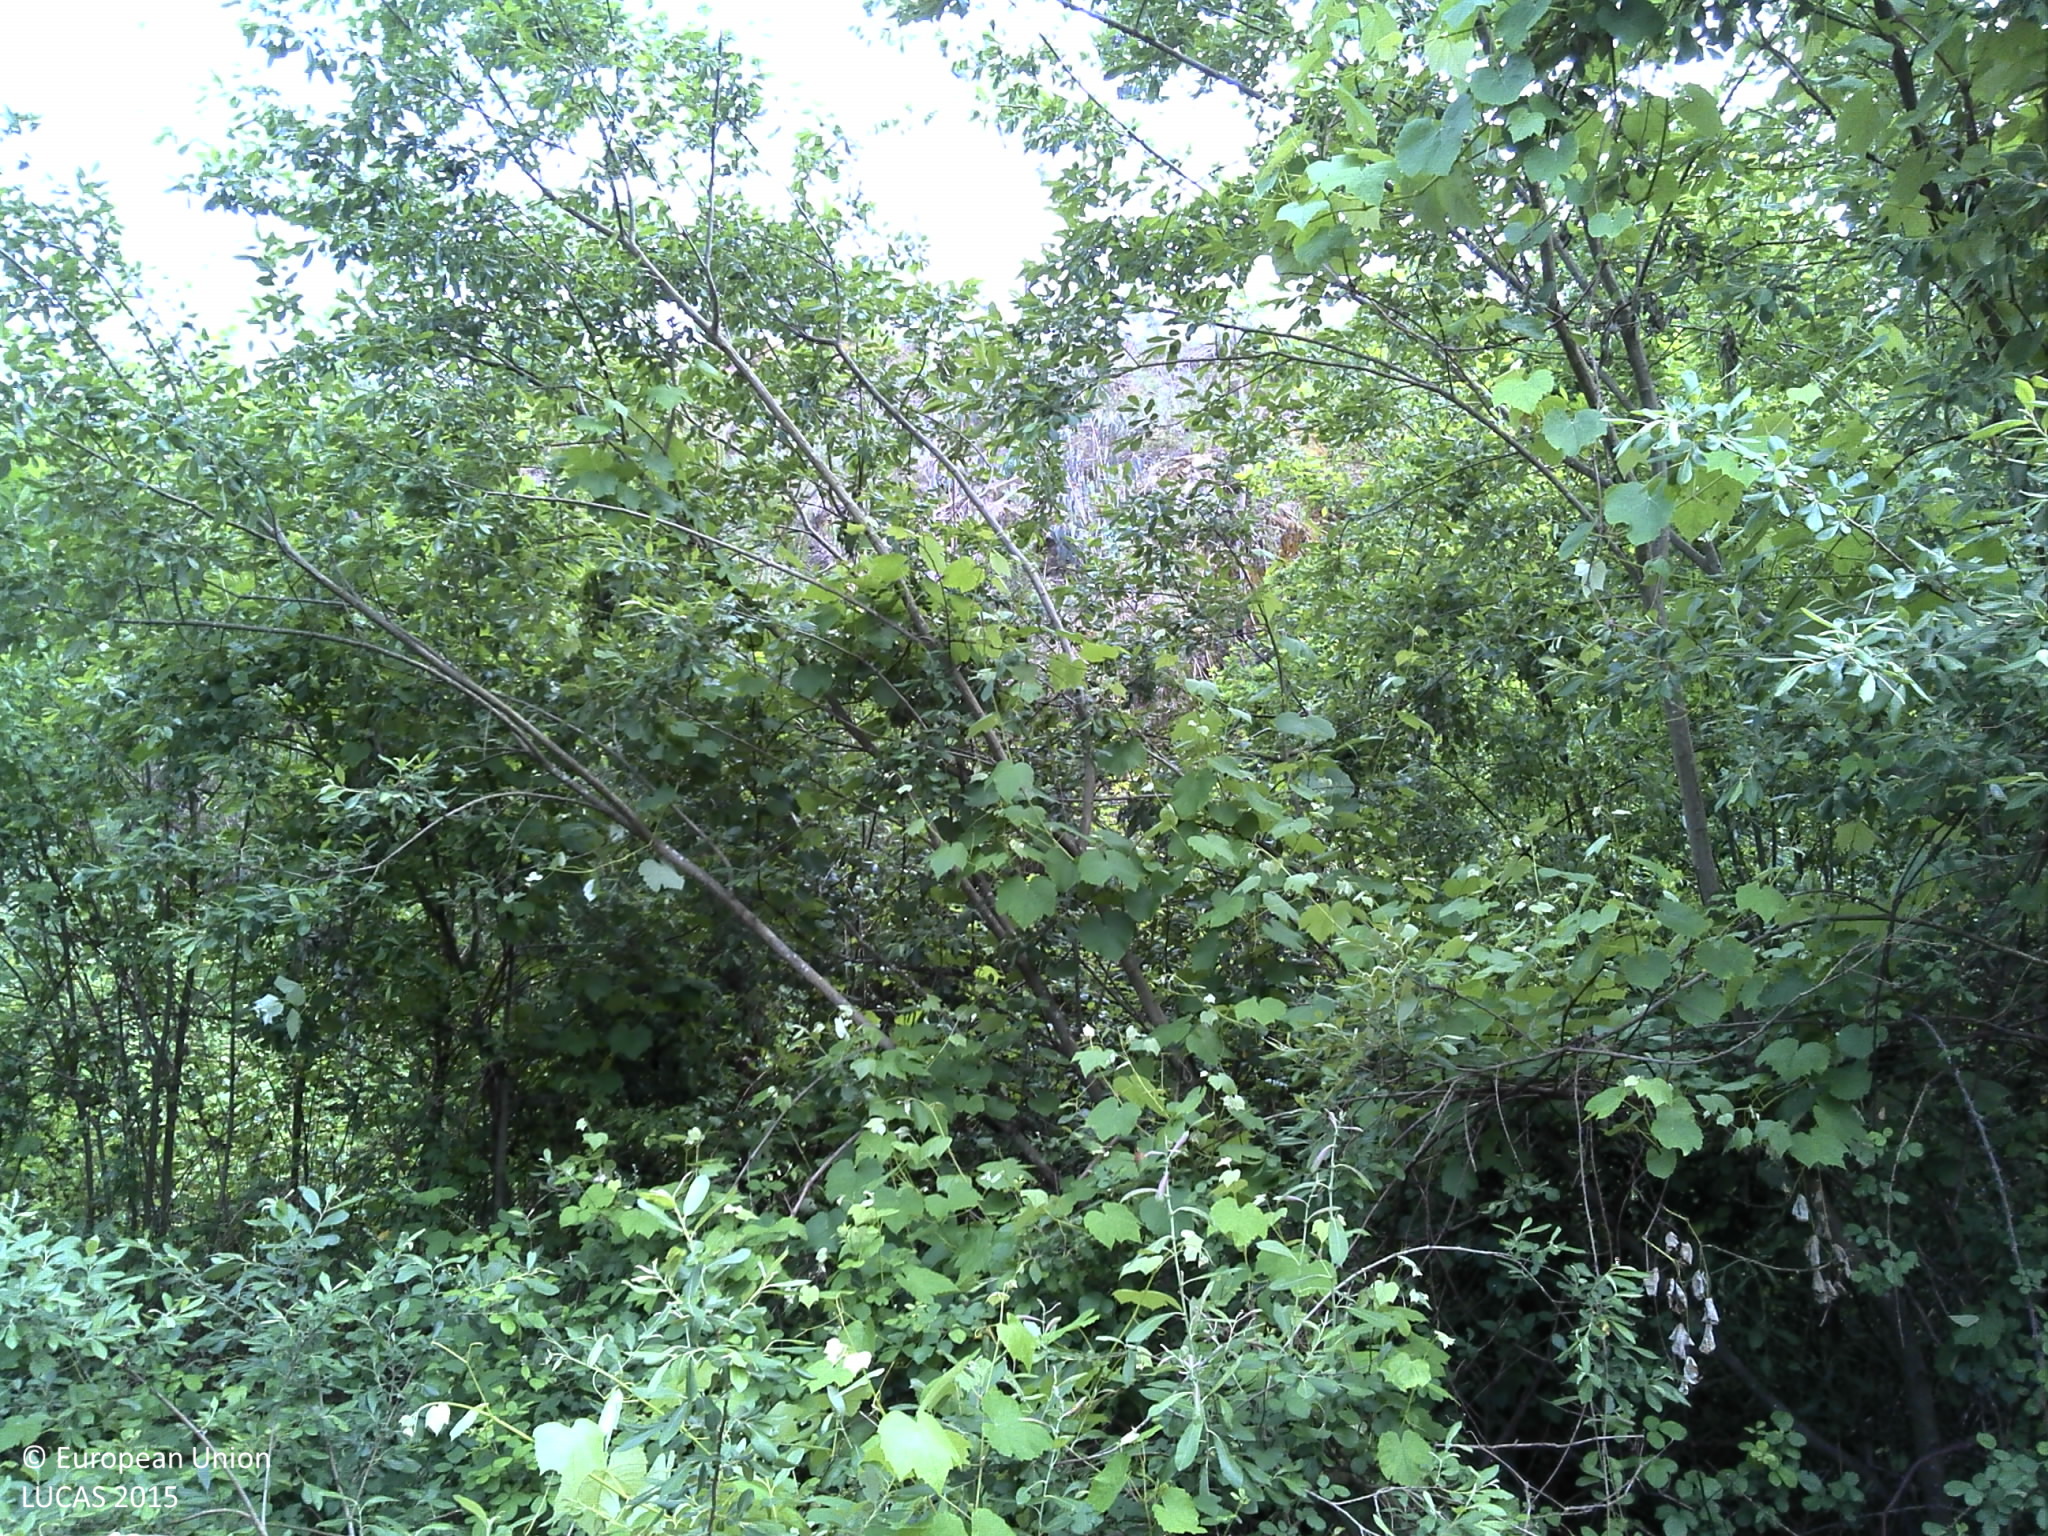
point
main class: Woodland
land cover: Broadleaved woodland
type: thermophilous deciduous forest
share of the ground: > 75 %
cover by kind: broadleaved forest trees 75 %, shrubs 20 %, unconsolidated bare surface 5 %
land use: Forestry
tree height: > 5 m
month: May
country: PT
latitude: 41.1341
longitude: -8.5067
